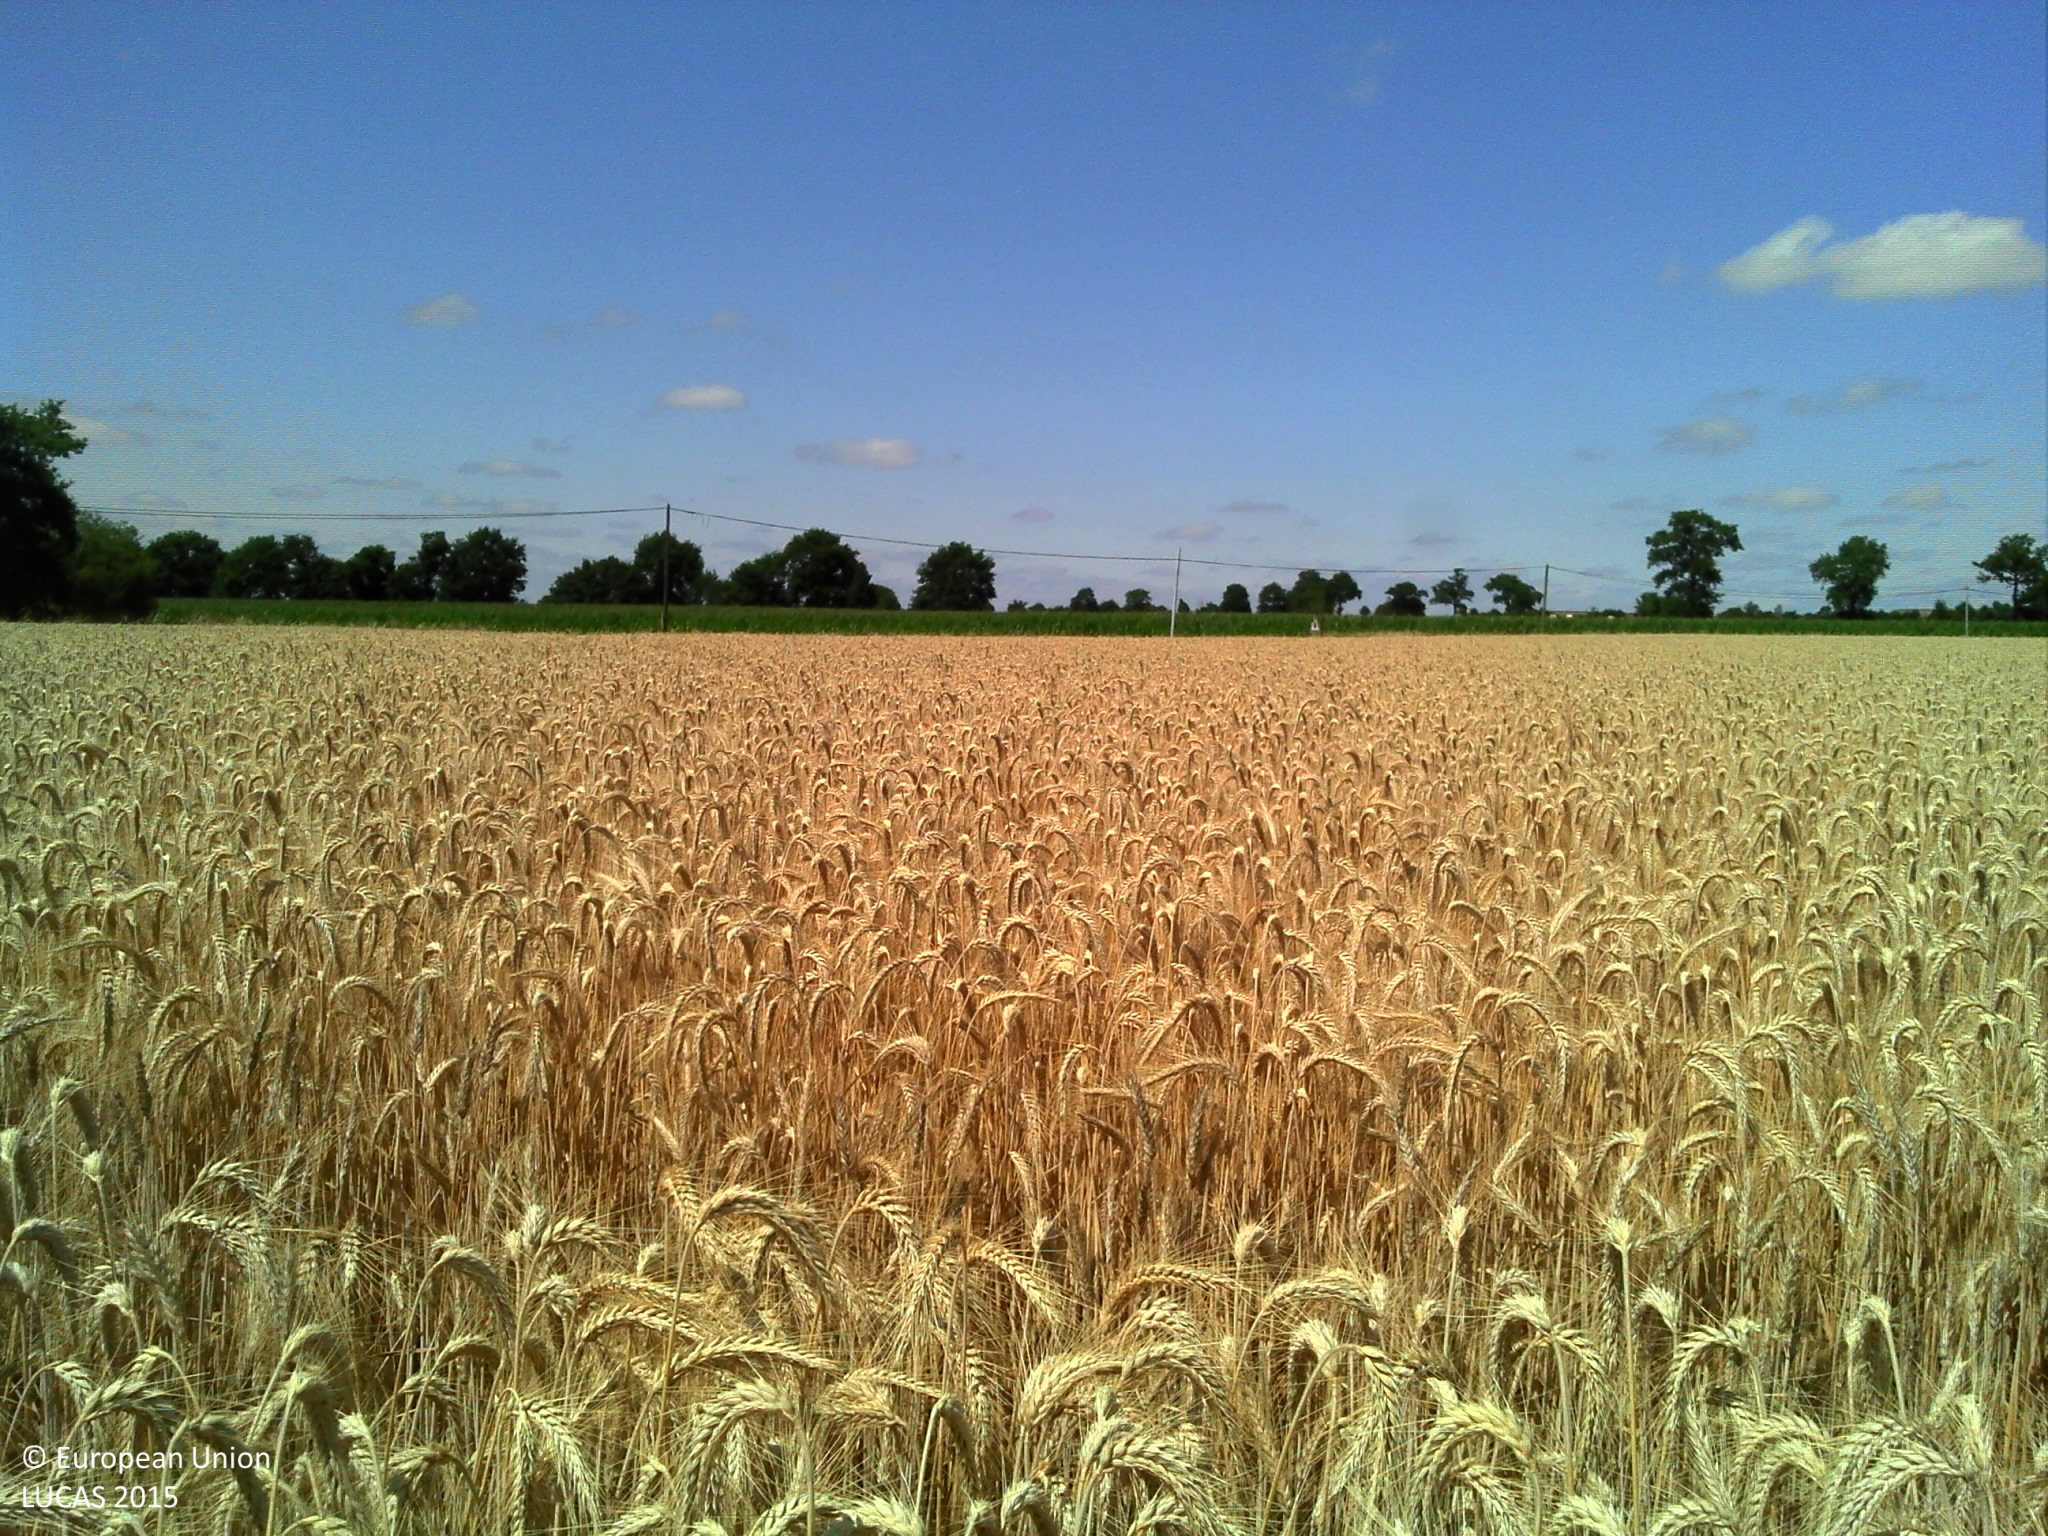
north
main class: Cropland
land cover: Barley
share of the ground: > 75 %
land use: Agriculture (excluding fallow land and kitchen gardens)
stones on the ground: < 10 %
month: July
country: FR
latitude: 47.8670
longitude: -1.3929
